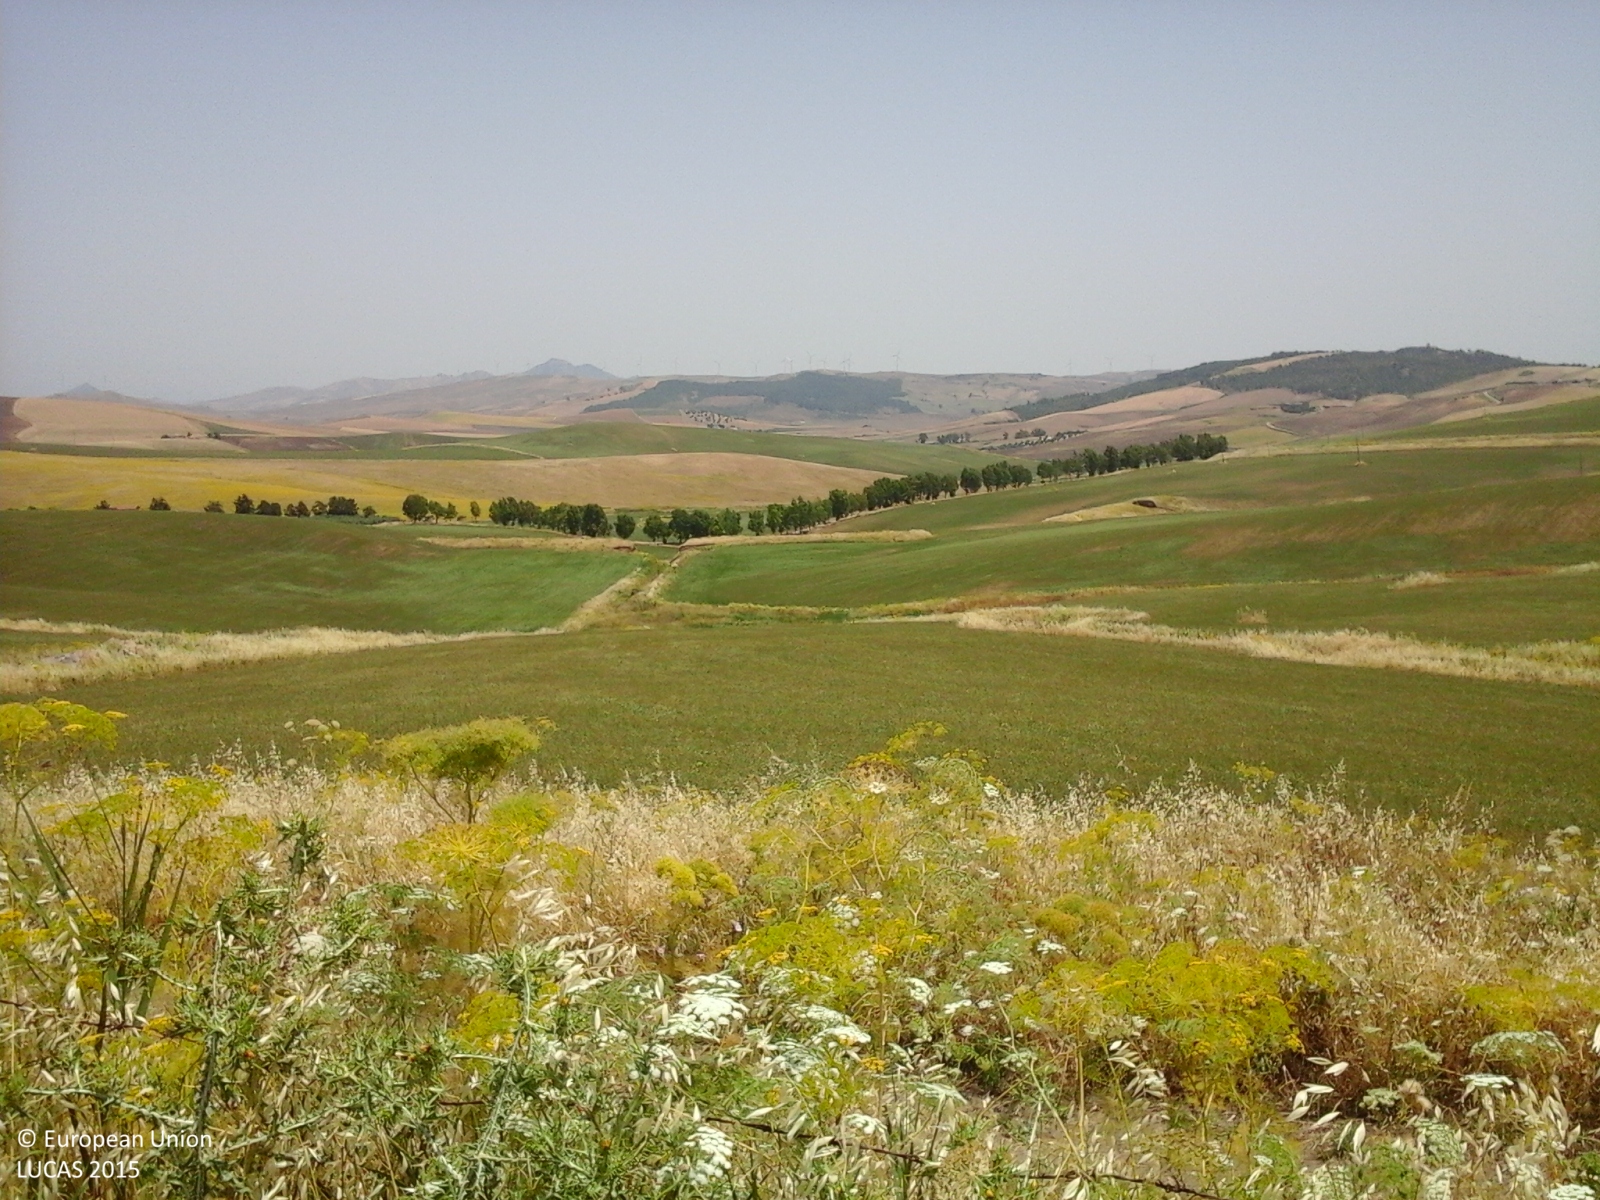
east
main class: Cropland
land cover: Clovers
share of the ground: > 75 %
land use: Agriculture (excluding fallow land and kitchen gardens)
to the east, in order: Clovers; Shrubland without tree cover; Clovers; Shrubland without tree cover; Ditches and canals; Shrubland without tree cover; Clovers; Shrubland without tree cover; Ditches and canals; Shrubland without tree cover; Clovers
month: June
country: IT
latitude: 37.4976
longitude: 14.4577
